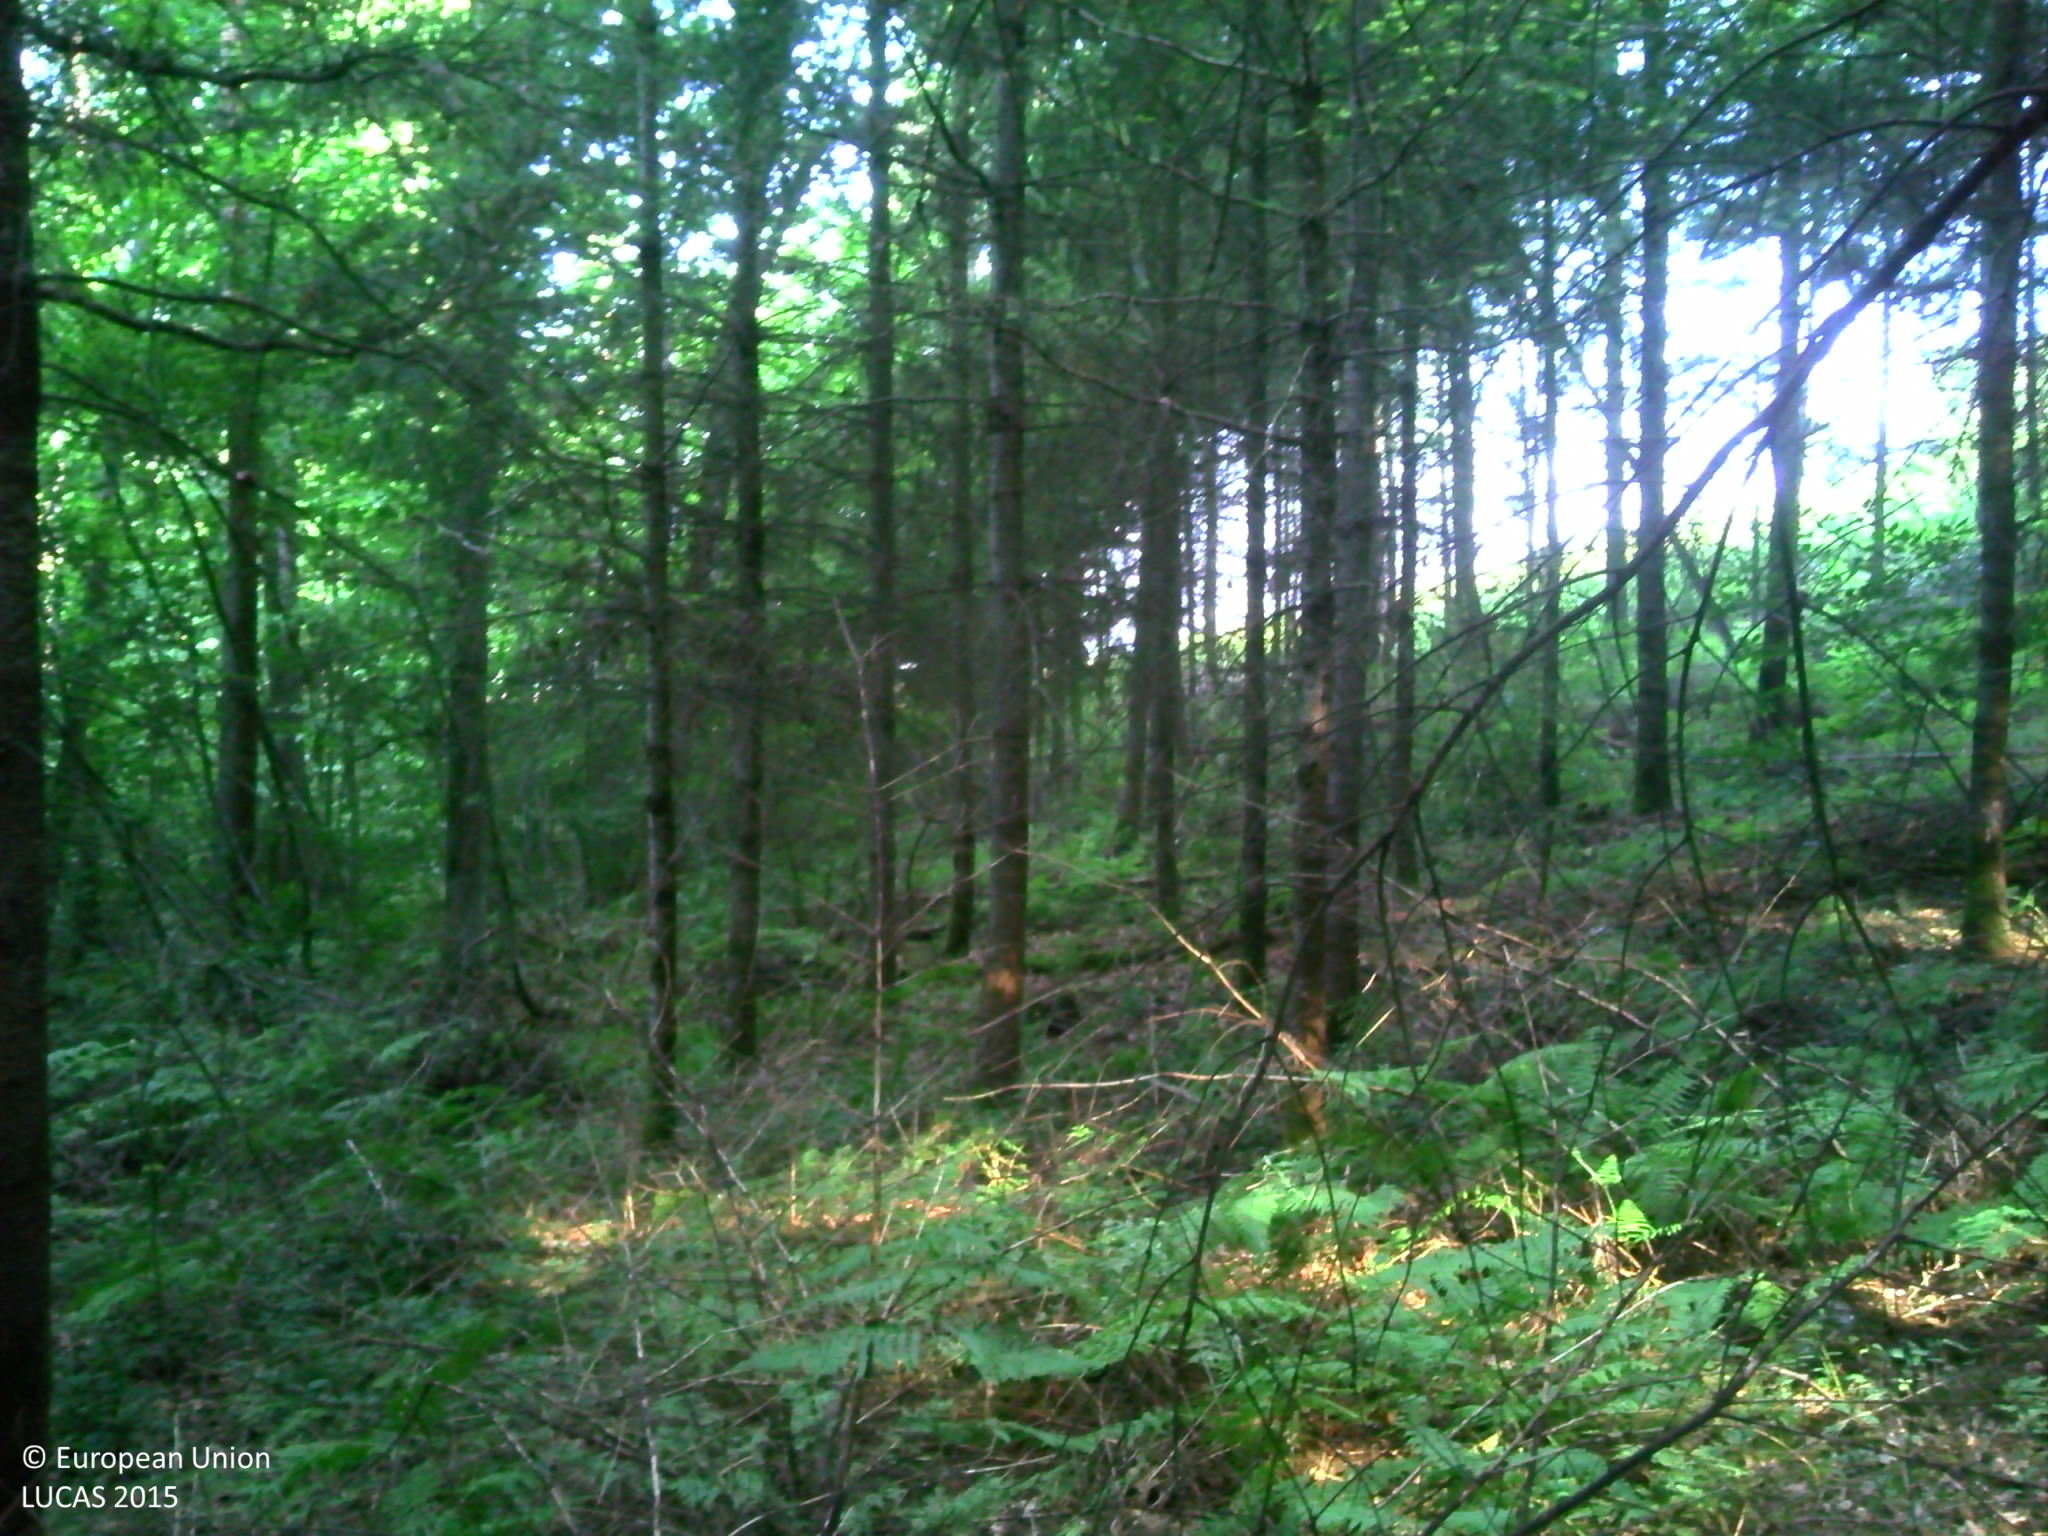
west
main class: Woodland
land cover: Spruce dominated coniferous woodland
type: exotic forest
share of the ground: > 75 %
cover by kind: coniferous forest trees 80 %, herbaceous plants 20 %
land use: Forestry
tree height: > 5 m
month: June
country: FR
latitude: 46.3862
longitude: 4.4231
